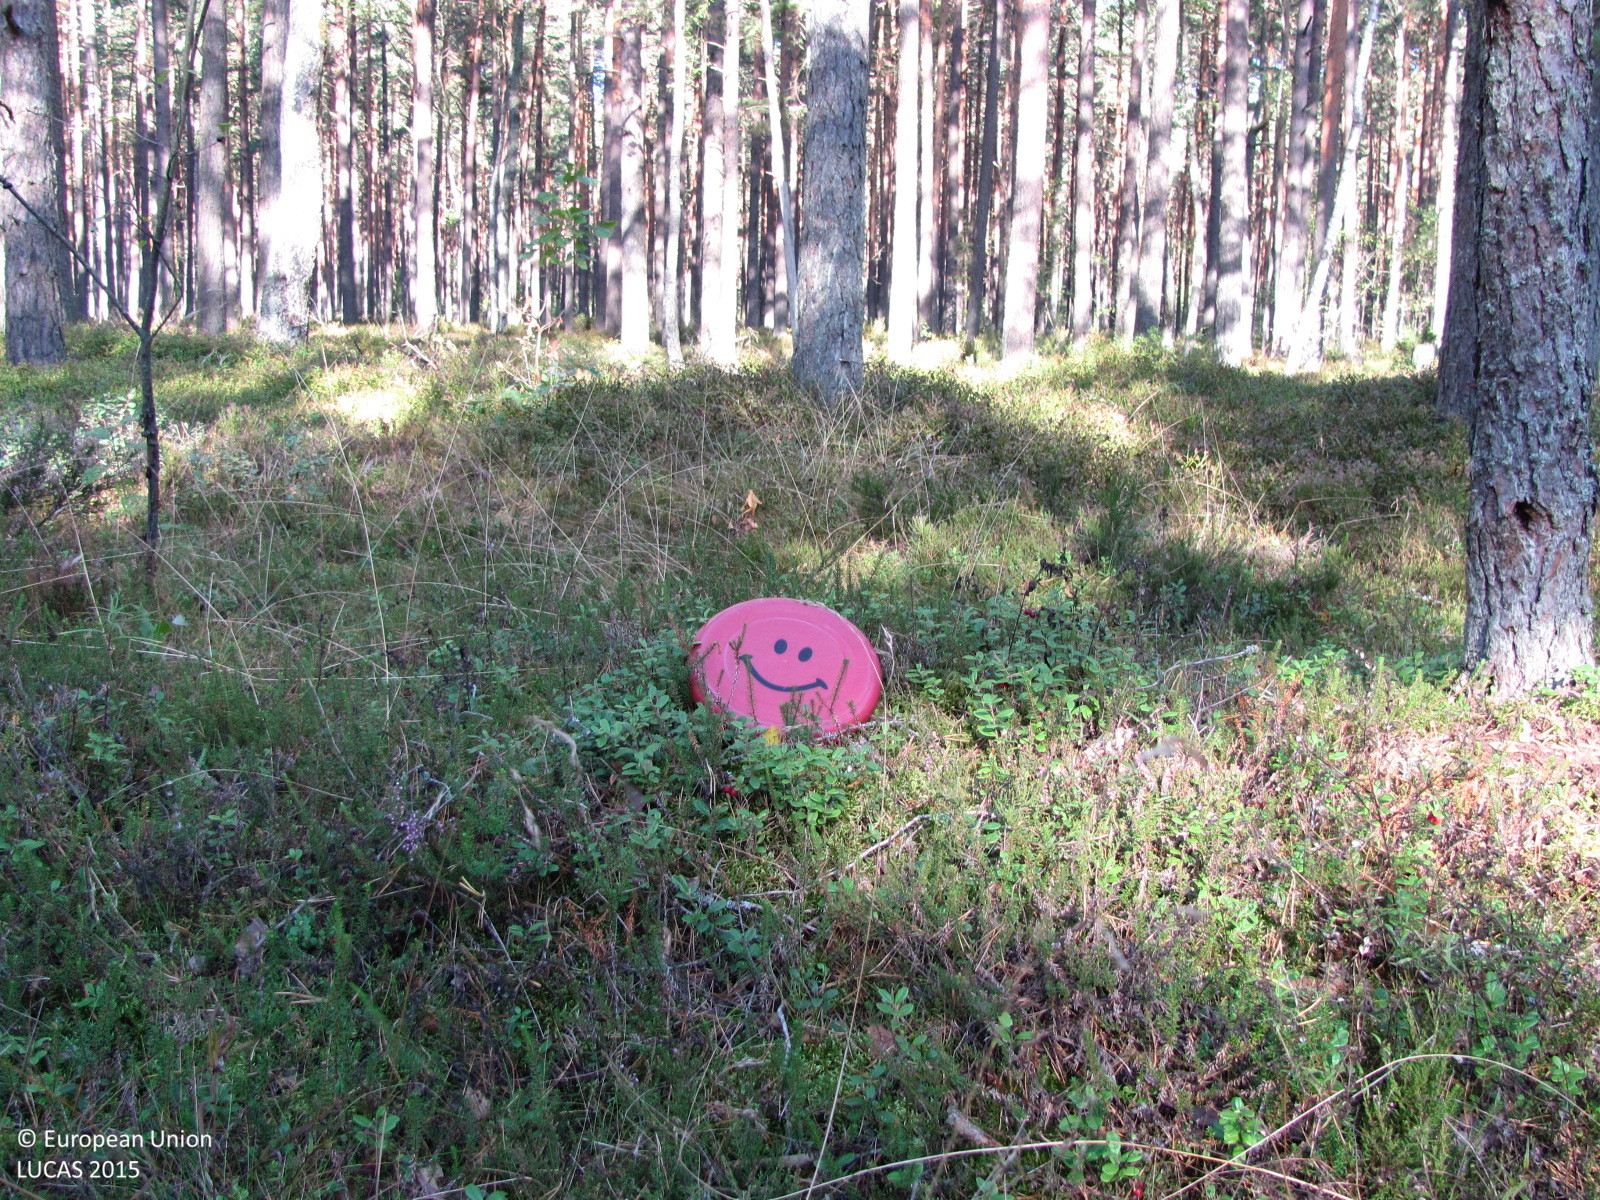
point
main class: Woodland
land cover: Pine dominated coniferous woodland
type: hemiboreal forest and nemoral coniferous forest and mixed broadleaved-coniferous forest
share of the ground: > 75 %
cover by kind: coniferous forest trees 80 %, herbaceous plants 10 %, lichens and mosses 10 %
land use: Forestry
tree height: > 5 m
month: September
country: LV
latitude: 57.1082
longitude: 24.2369
